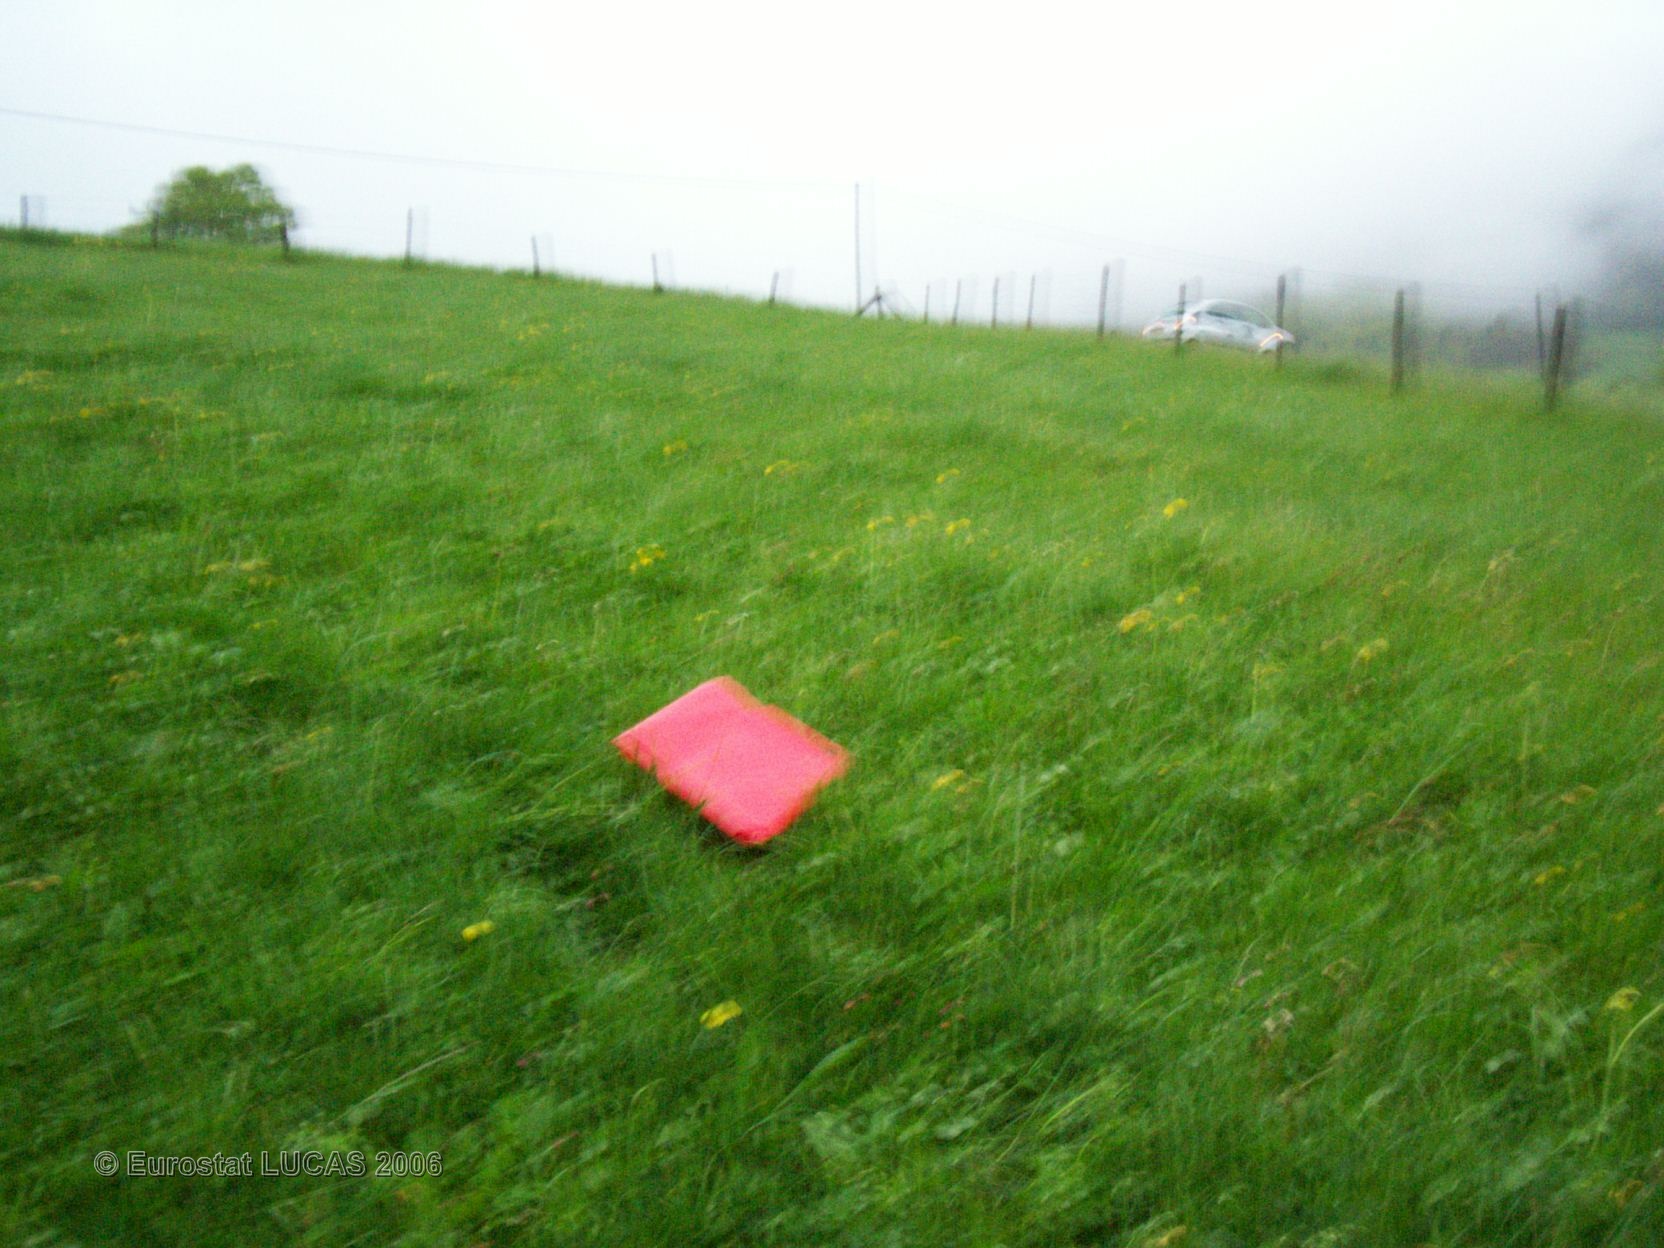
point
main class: Grassland
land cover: Grassland without tree/shrub cover
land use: Agriculture (excluding fallow land and kitchen gardens)
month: May
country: FR
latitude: 45.7404
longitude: 6.1357
